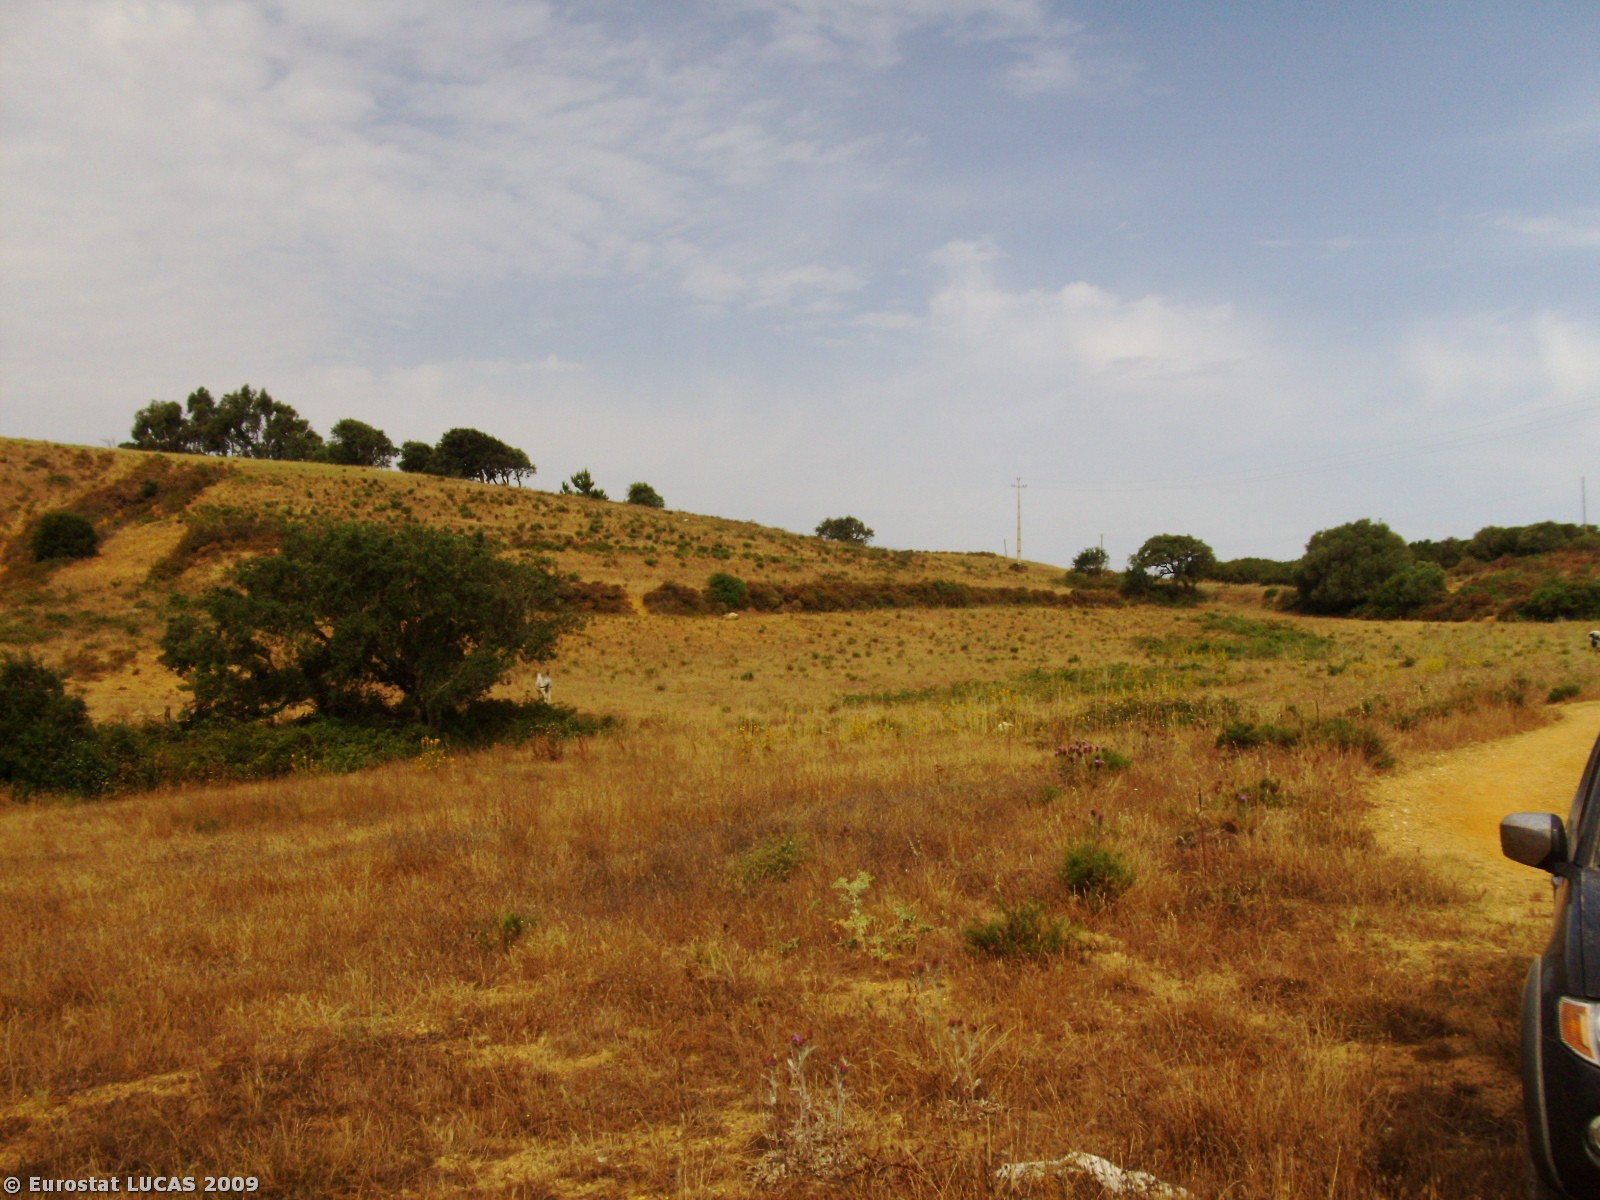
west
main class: Grassland
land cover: Spontaneously vegetated surfaces
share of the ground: > 75 %
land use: Fallow land
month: June
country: PT
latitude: 37.3411
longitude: -8.7850
